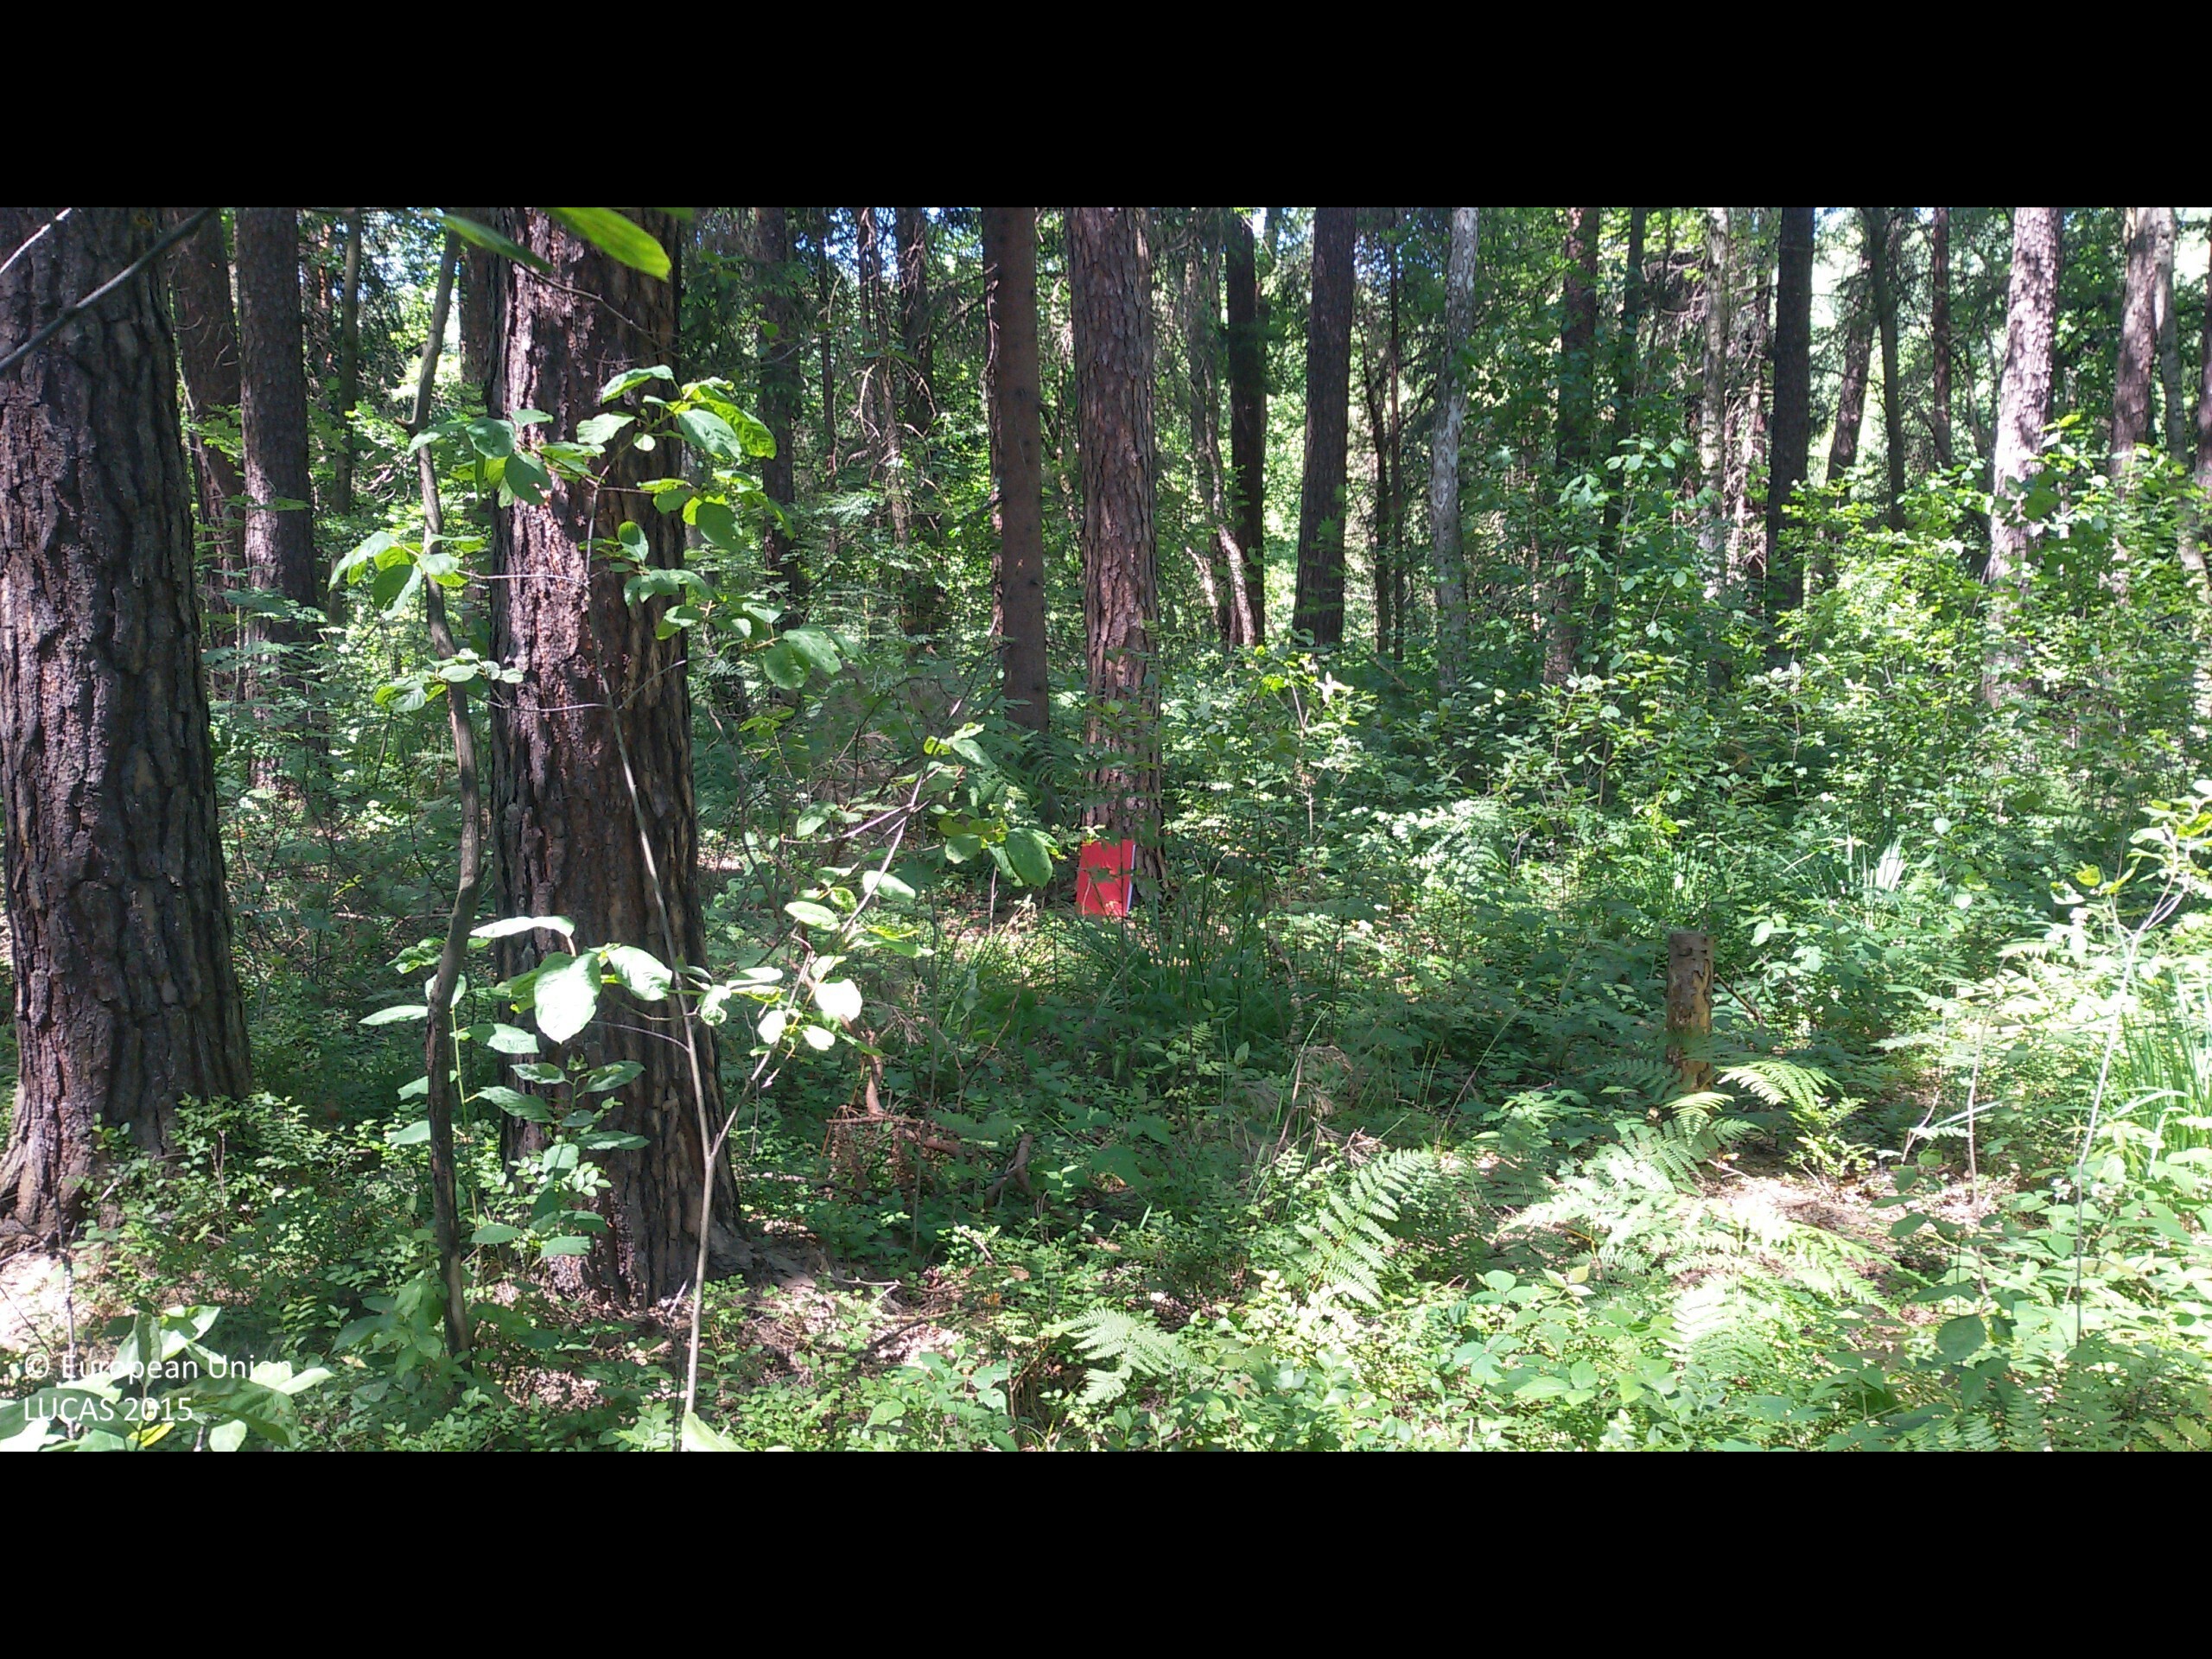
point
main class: Woodland
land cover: Pine dominated coniferous woodland
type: hemiboreal forest and nemoral coniferous forest and mixed broadleaved-coniferous forest
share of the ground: > 75 %
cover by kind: coniferous forest trees 75 %, broadleaved forest trees 10 %, herbaceous plants 10 %, shrubs 5 %
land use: Forestry
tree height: > 5 m
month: July
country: PL
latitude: 50.0690
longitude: 19.3728
